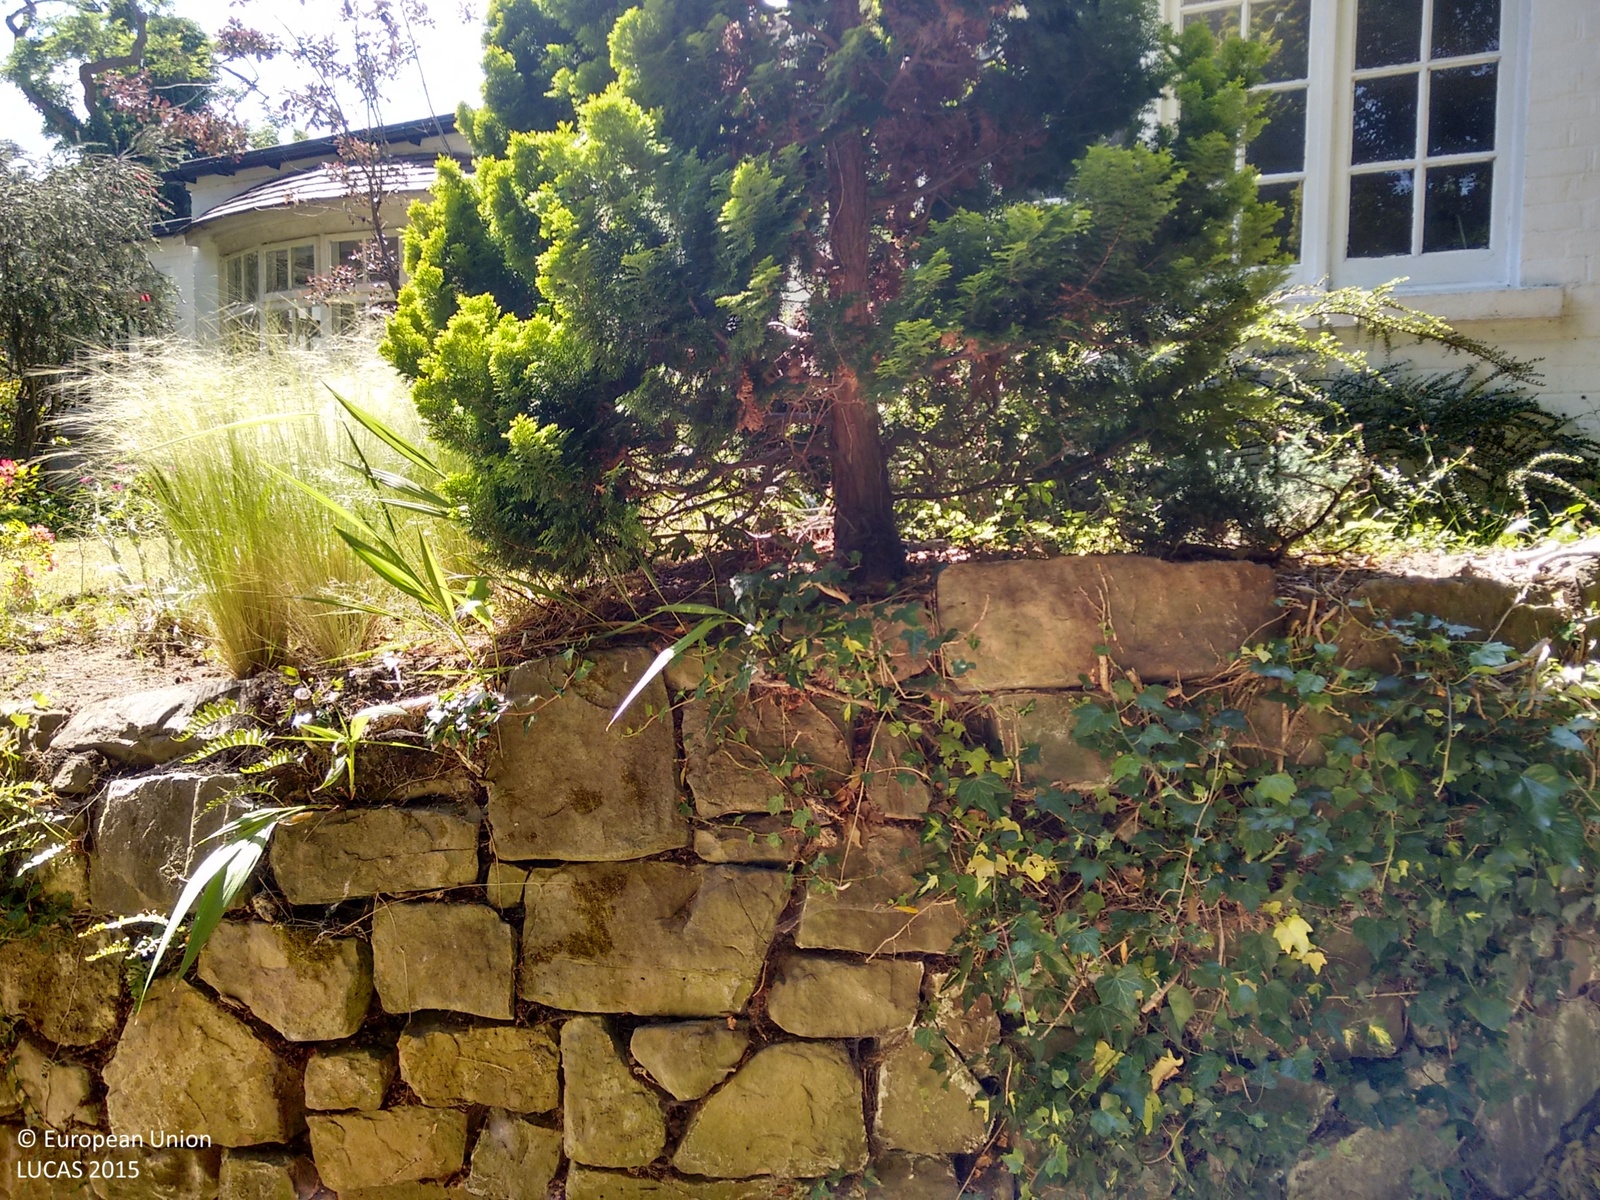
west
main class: Grassland
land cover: Grassland with sparse tree/shrub cover
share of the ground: > 75 %
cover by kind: herbaceous plants 85 %, shrubs 10 %, broadleaved forest trees 5 %
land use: Residential
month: June
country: GB
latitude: 51.2286
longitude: -0.2170
